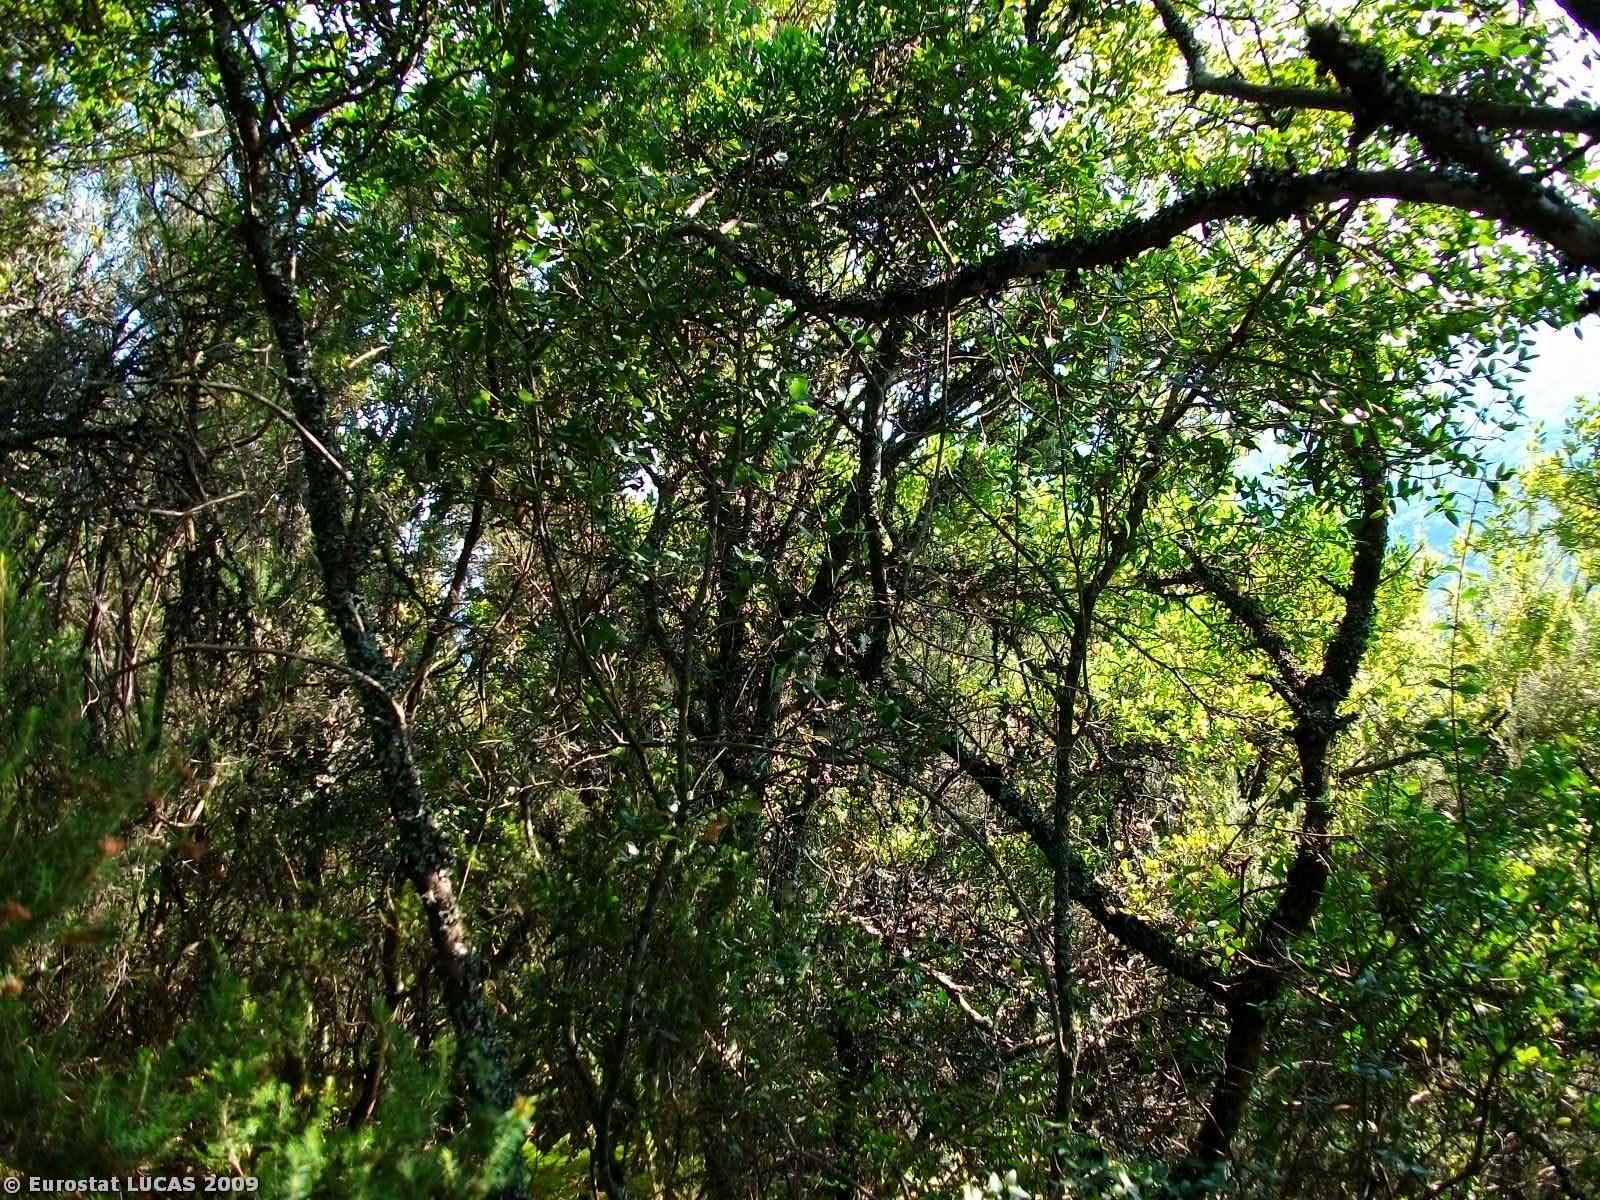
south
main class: Woodland
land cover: Mixed woodland
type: mesophytic deciduous forest
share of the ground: > 75 %
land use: Forestry
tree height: > 5 m
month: August
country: GR
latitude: 39.6501
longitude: 20.4766
